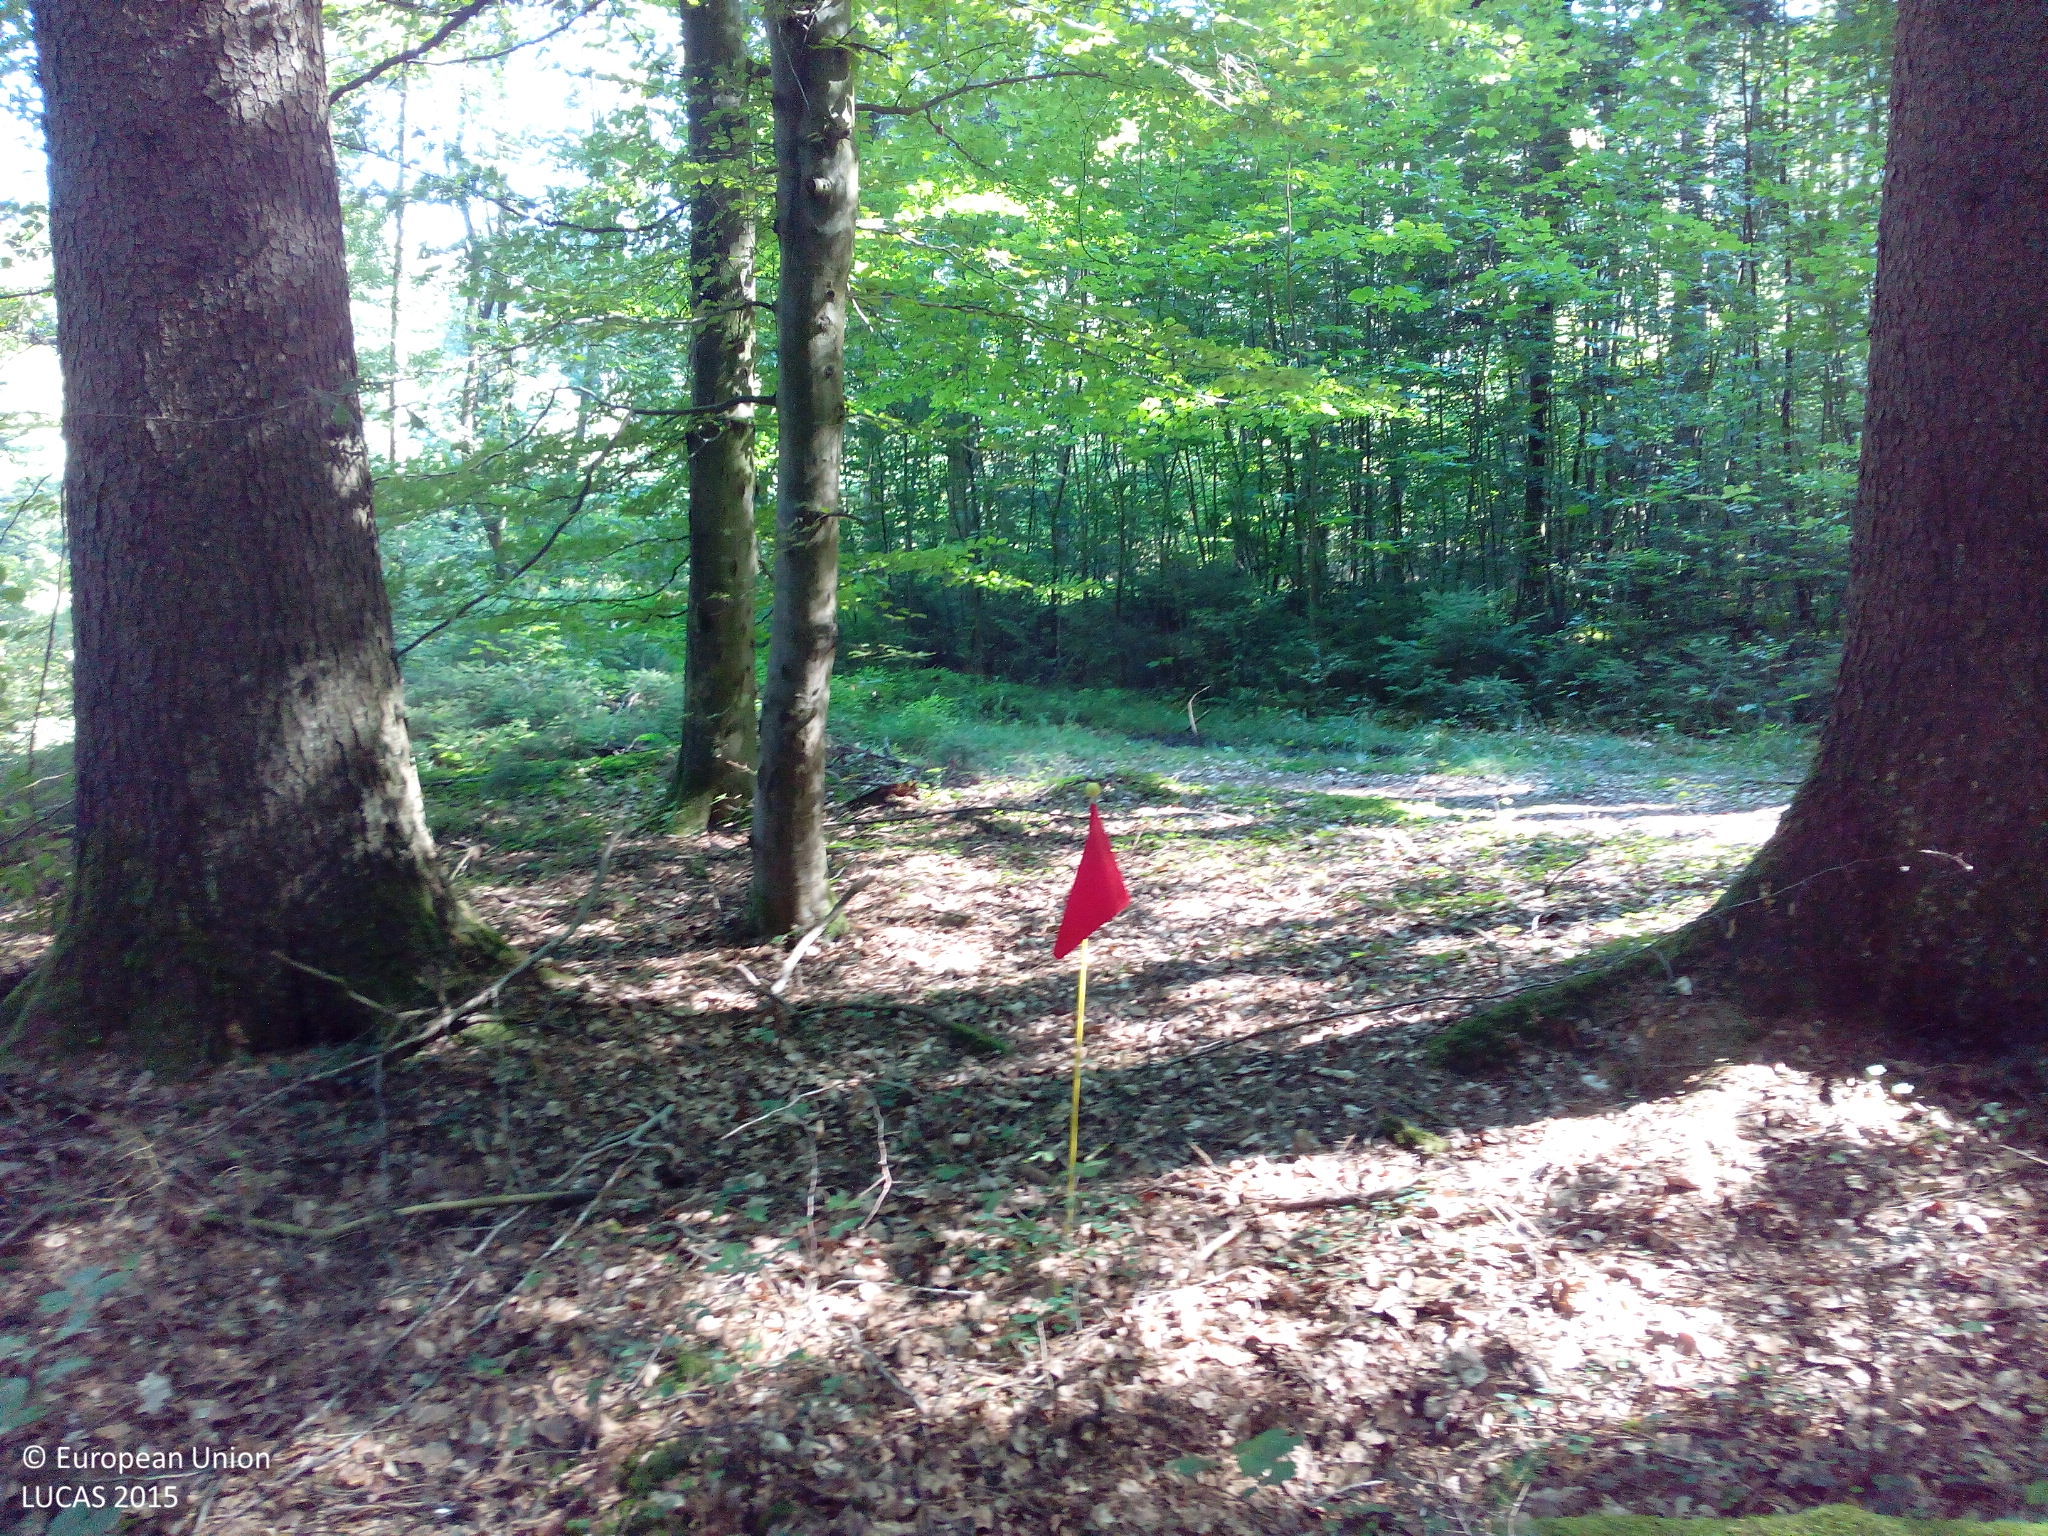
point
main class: Woodland
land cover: Other mixed woodland
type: hemiboreal forest and nemoral coniferous forest and mixed broadleaved-coniferous forest
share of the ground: > 75 %
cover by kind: coniferous forest trees 50 %, broadleaved forest trees 50 %
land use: Forestry
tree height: > 5 m
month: August
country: DE
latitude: 48.0905
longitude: 12.3484
